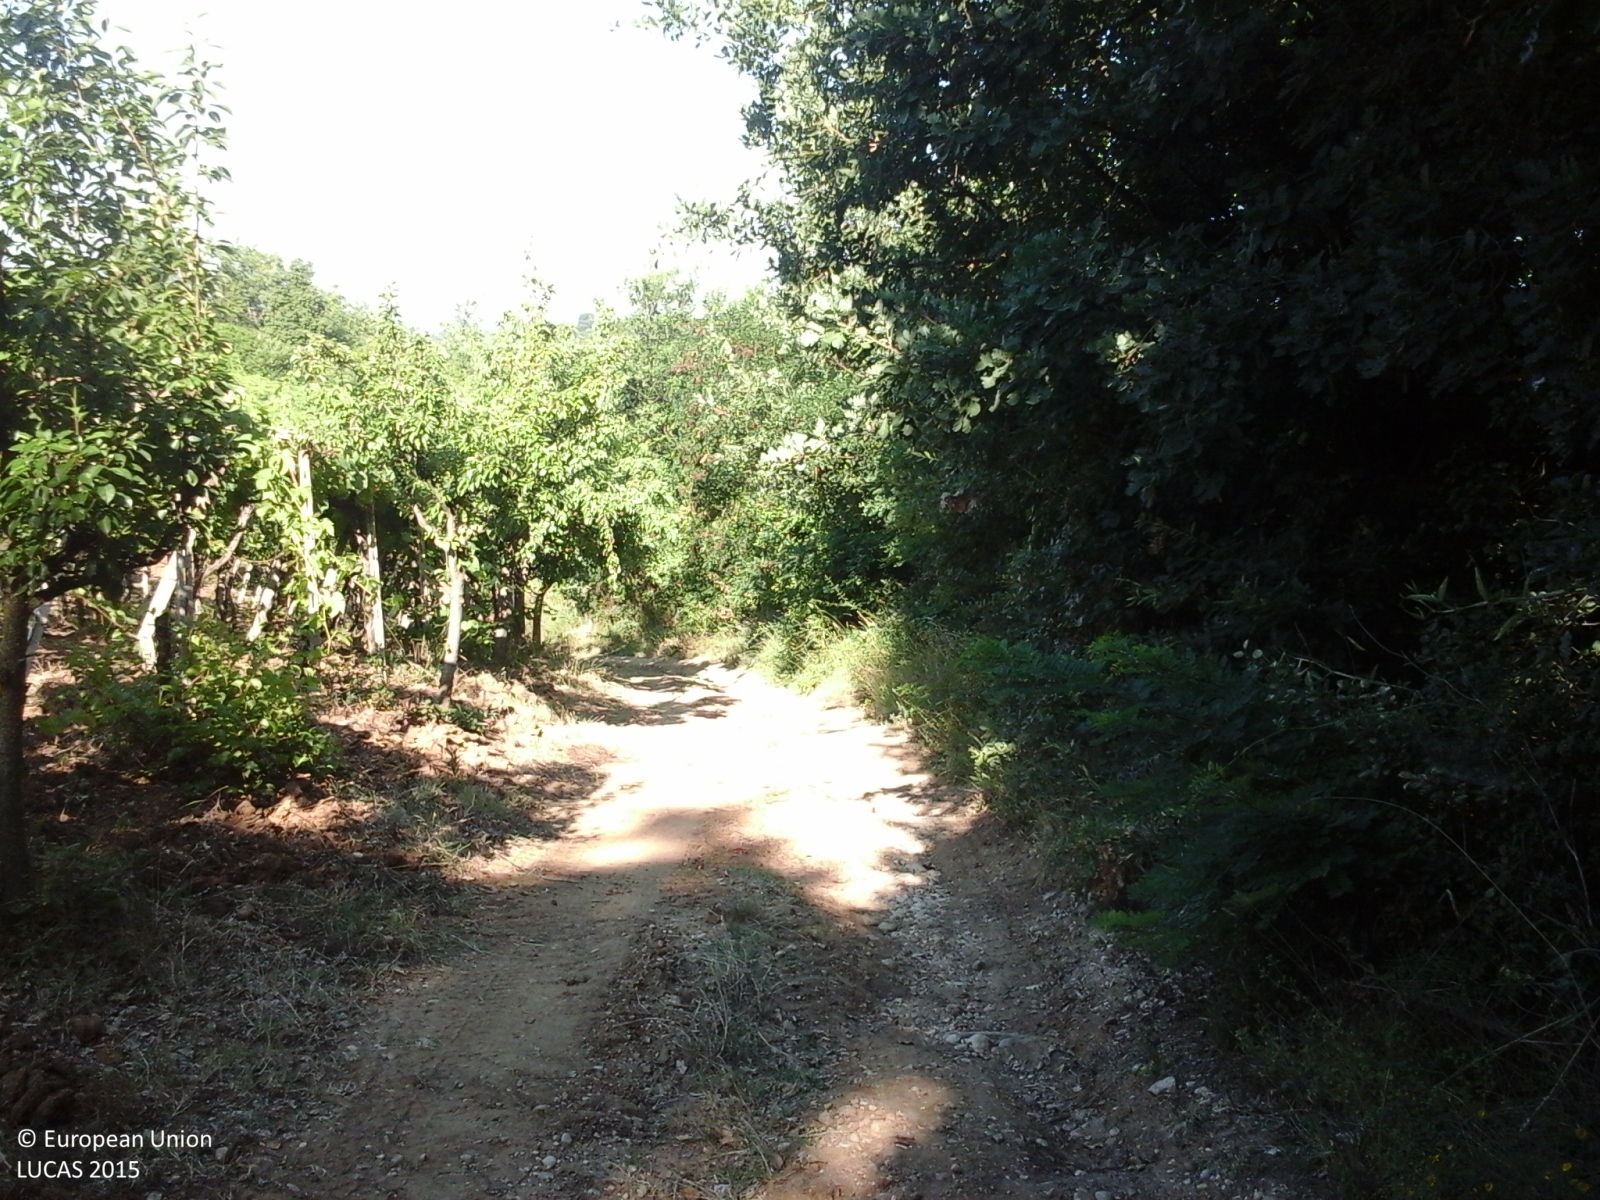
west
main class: Woodland
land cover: Broadleaved woodland
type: thermophilous deciduous forest
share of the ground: > 75 %
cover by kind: broadleaved forest trees 80 %, shrubs 10 %, herbaceous plants 10 %
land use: Semi-natural and natural areas not in use
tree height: > 5 m
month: July
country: IT
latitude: 42.3046
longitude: 14.4145
